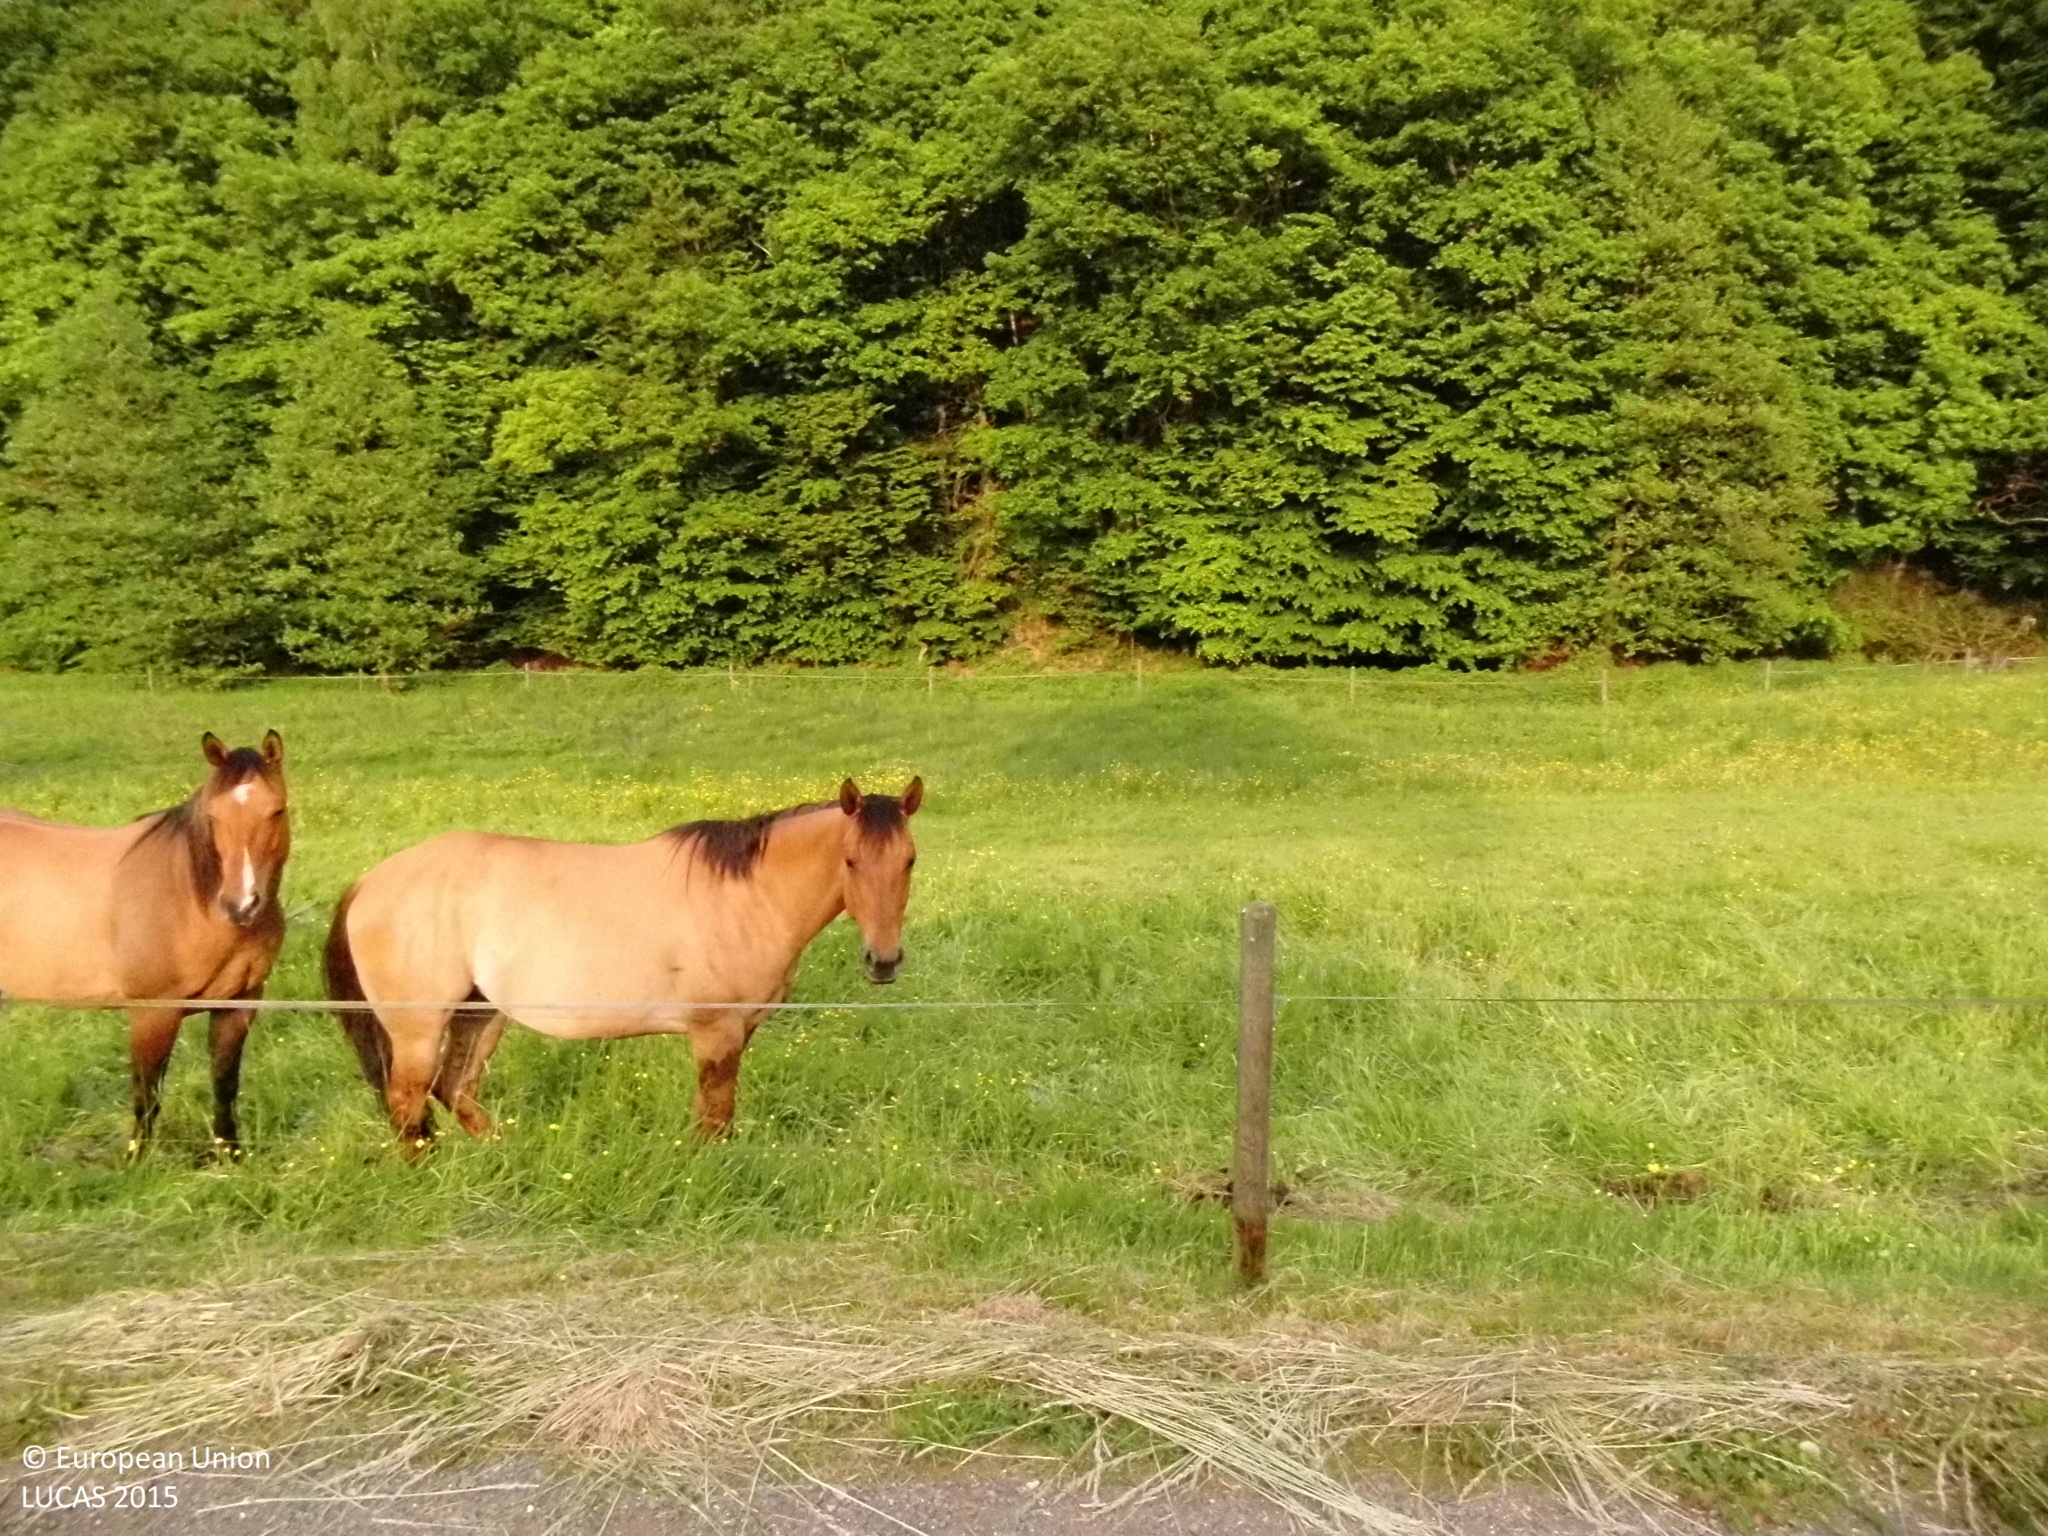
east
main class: Grassland
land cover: Grassland without tree/shrub cover
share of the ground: > 75 %
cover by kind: herbaceous plants 100 %
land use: Agriculture (excluding fallow land and kitchen gardens)
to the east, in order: Grassland without tree/shrub cover; Fences; Electric lines; Grass margins; Tracks; Grass margins; Fences; Grassland without tree/shrub cover; Fences; Shruby margins; Rivers and streams; Grassland with sparse tree/shrub cover; Broadleaved woodland
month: May
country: DE
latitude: 50.5886
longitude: 7.5001
